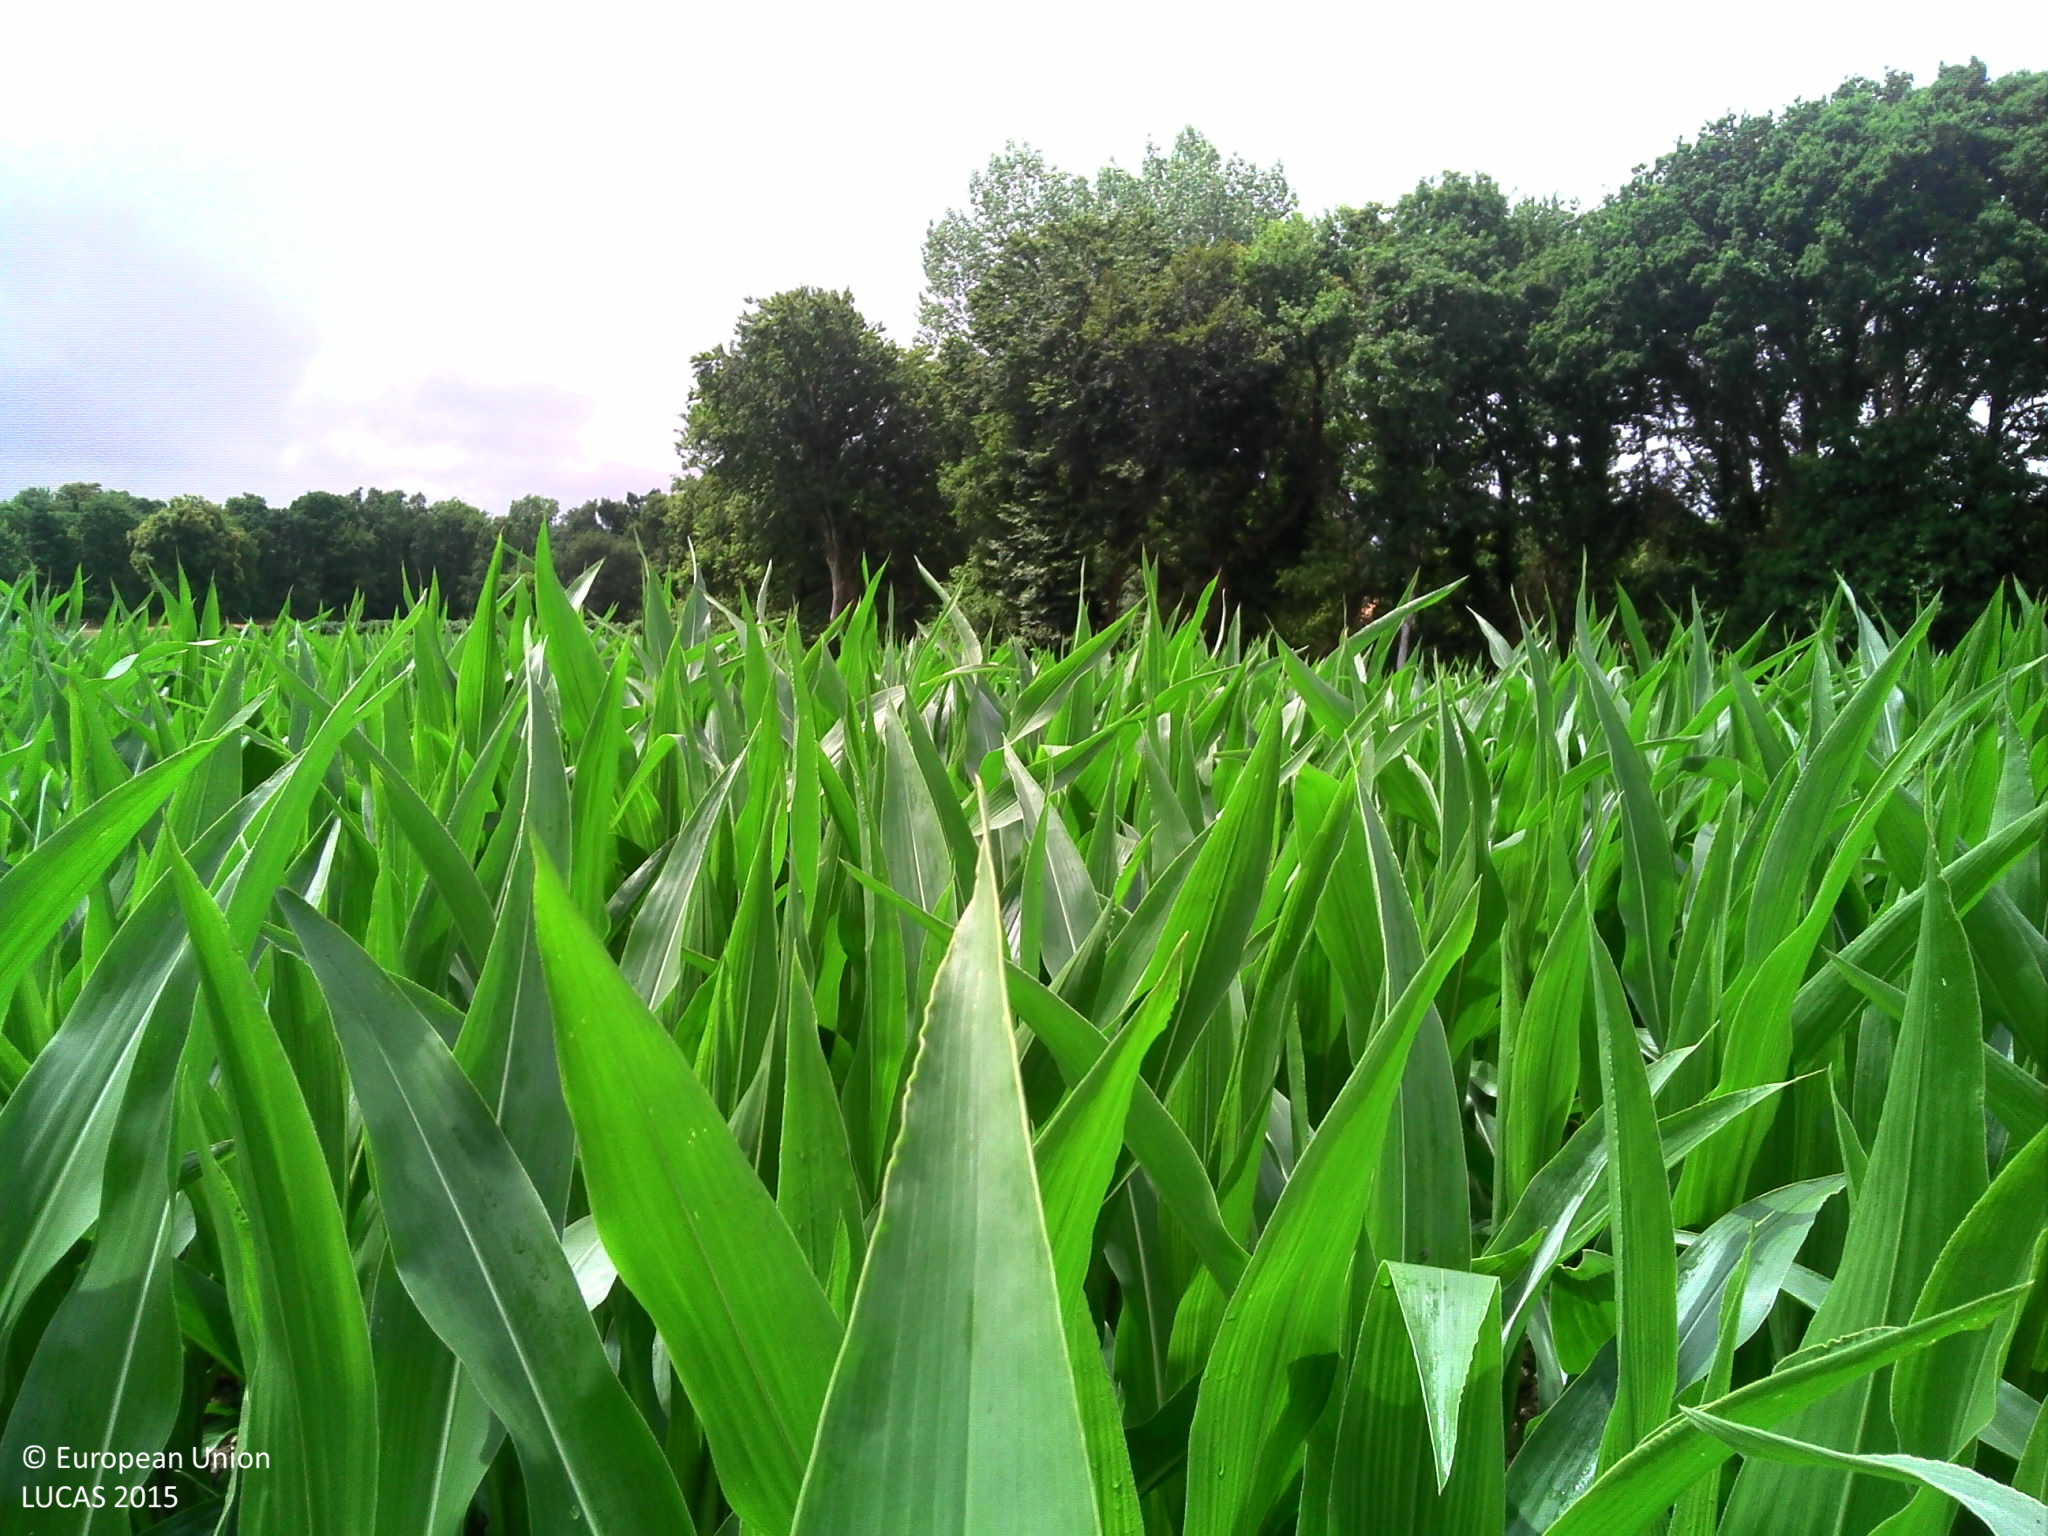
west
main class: Cropland
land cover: Maize
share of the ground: > 75 %
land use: Agriculture (excluding fallow land and kitchen gardens)
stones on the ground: < 10 %
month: July
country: FR
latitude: 48.6179
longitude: -3.4400
